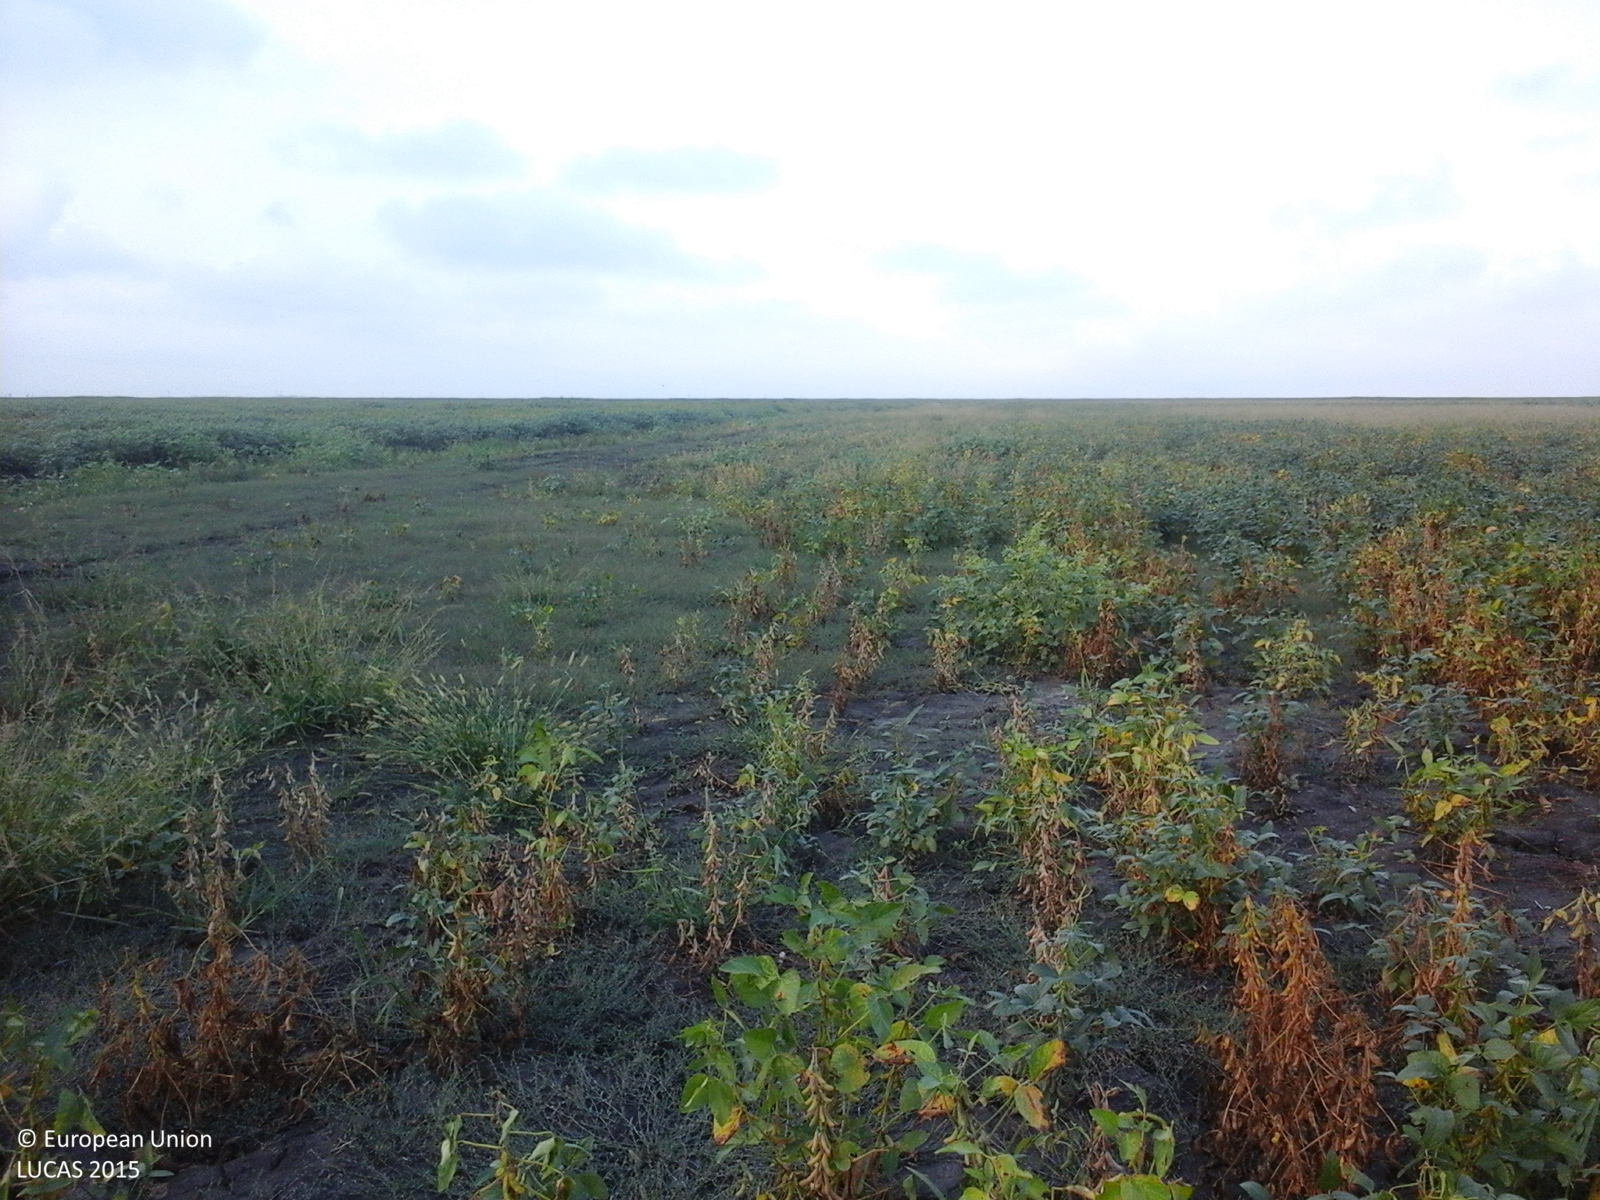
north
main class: Cropland
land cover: Soya
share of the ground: > 75 %
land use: Agriculture (excluding fallow land and kitchen gardens)
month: August
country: RO
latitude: 45.9637
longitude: 20.4629
